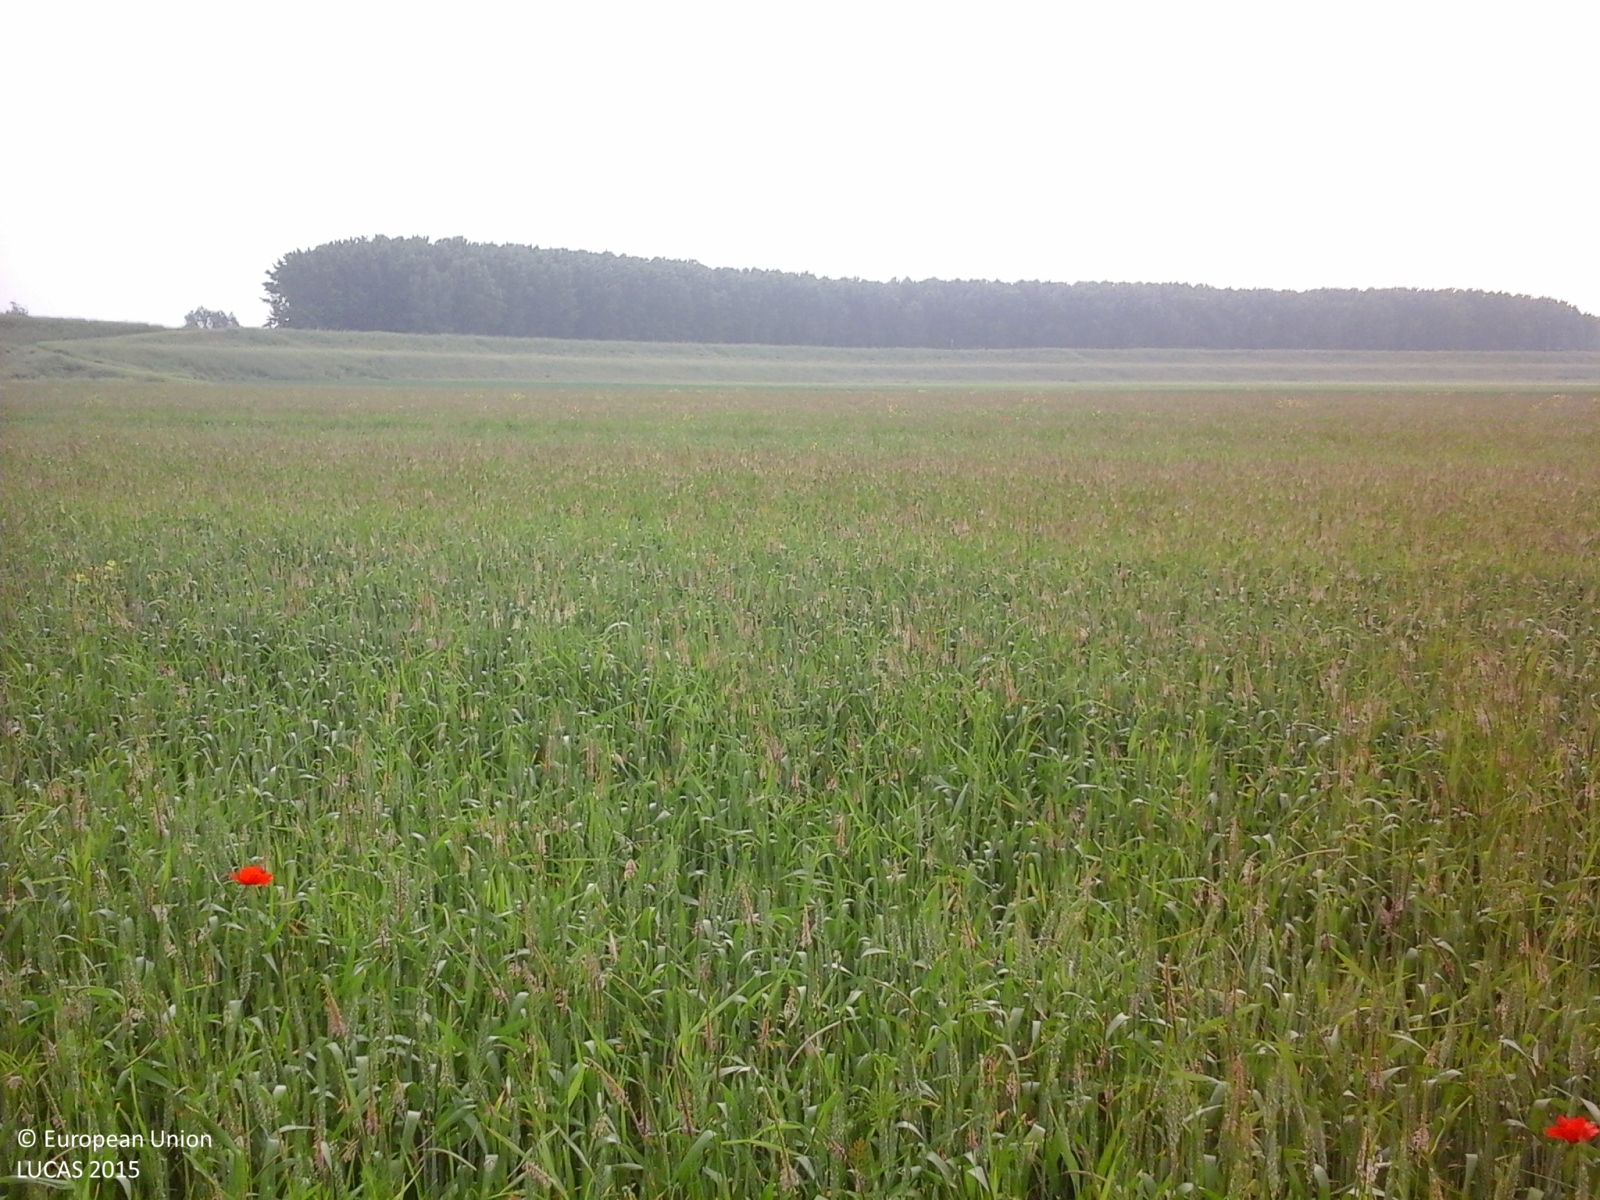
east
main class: Cropland
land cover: Common wheat
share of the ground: > 75 %
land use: Agriculture (excluding fallow land and kitchen gardens)
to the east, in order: Common wheat; Ditches and canals; Common wheat; Ditches and canals; Common wheat
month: May
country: IT
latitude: 45.0339
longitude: 10.6208
